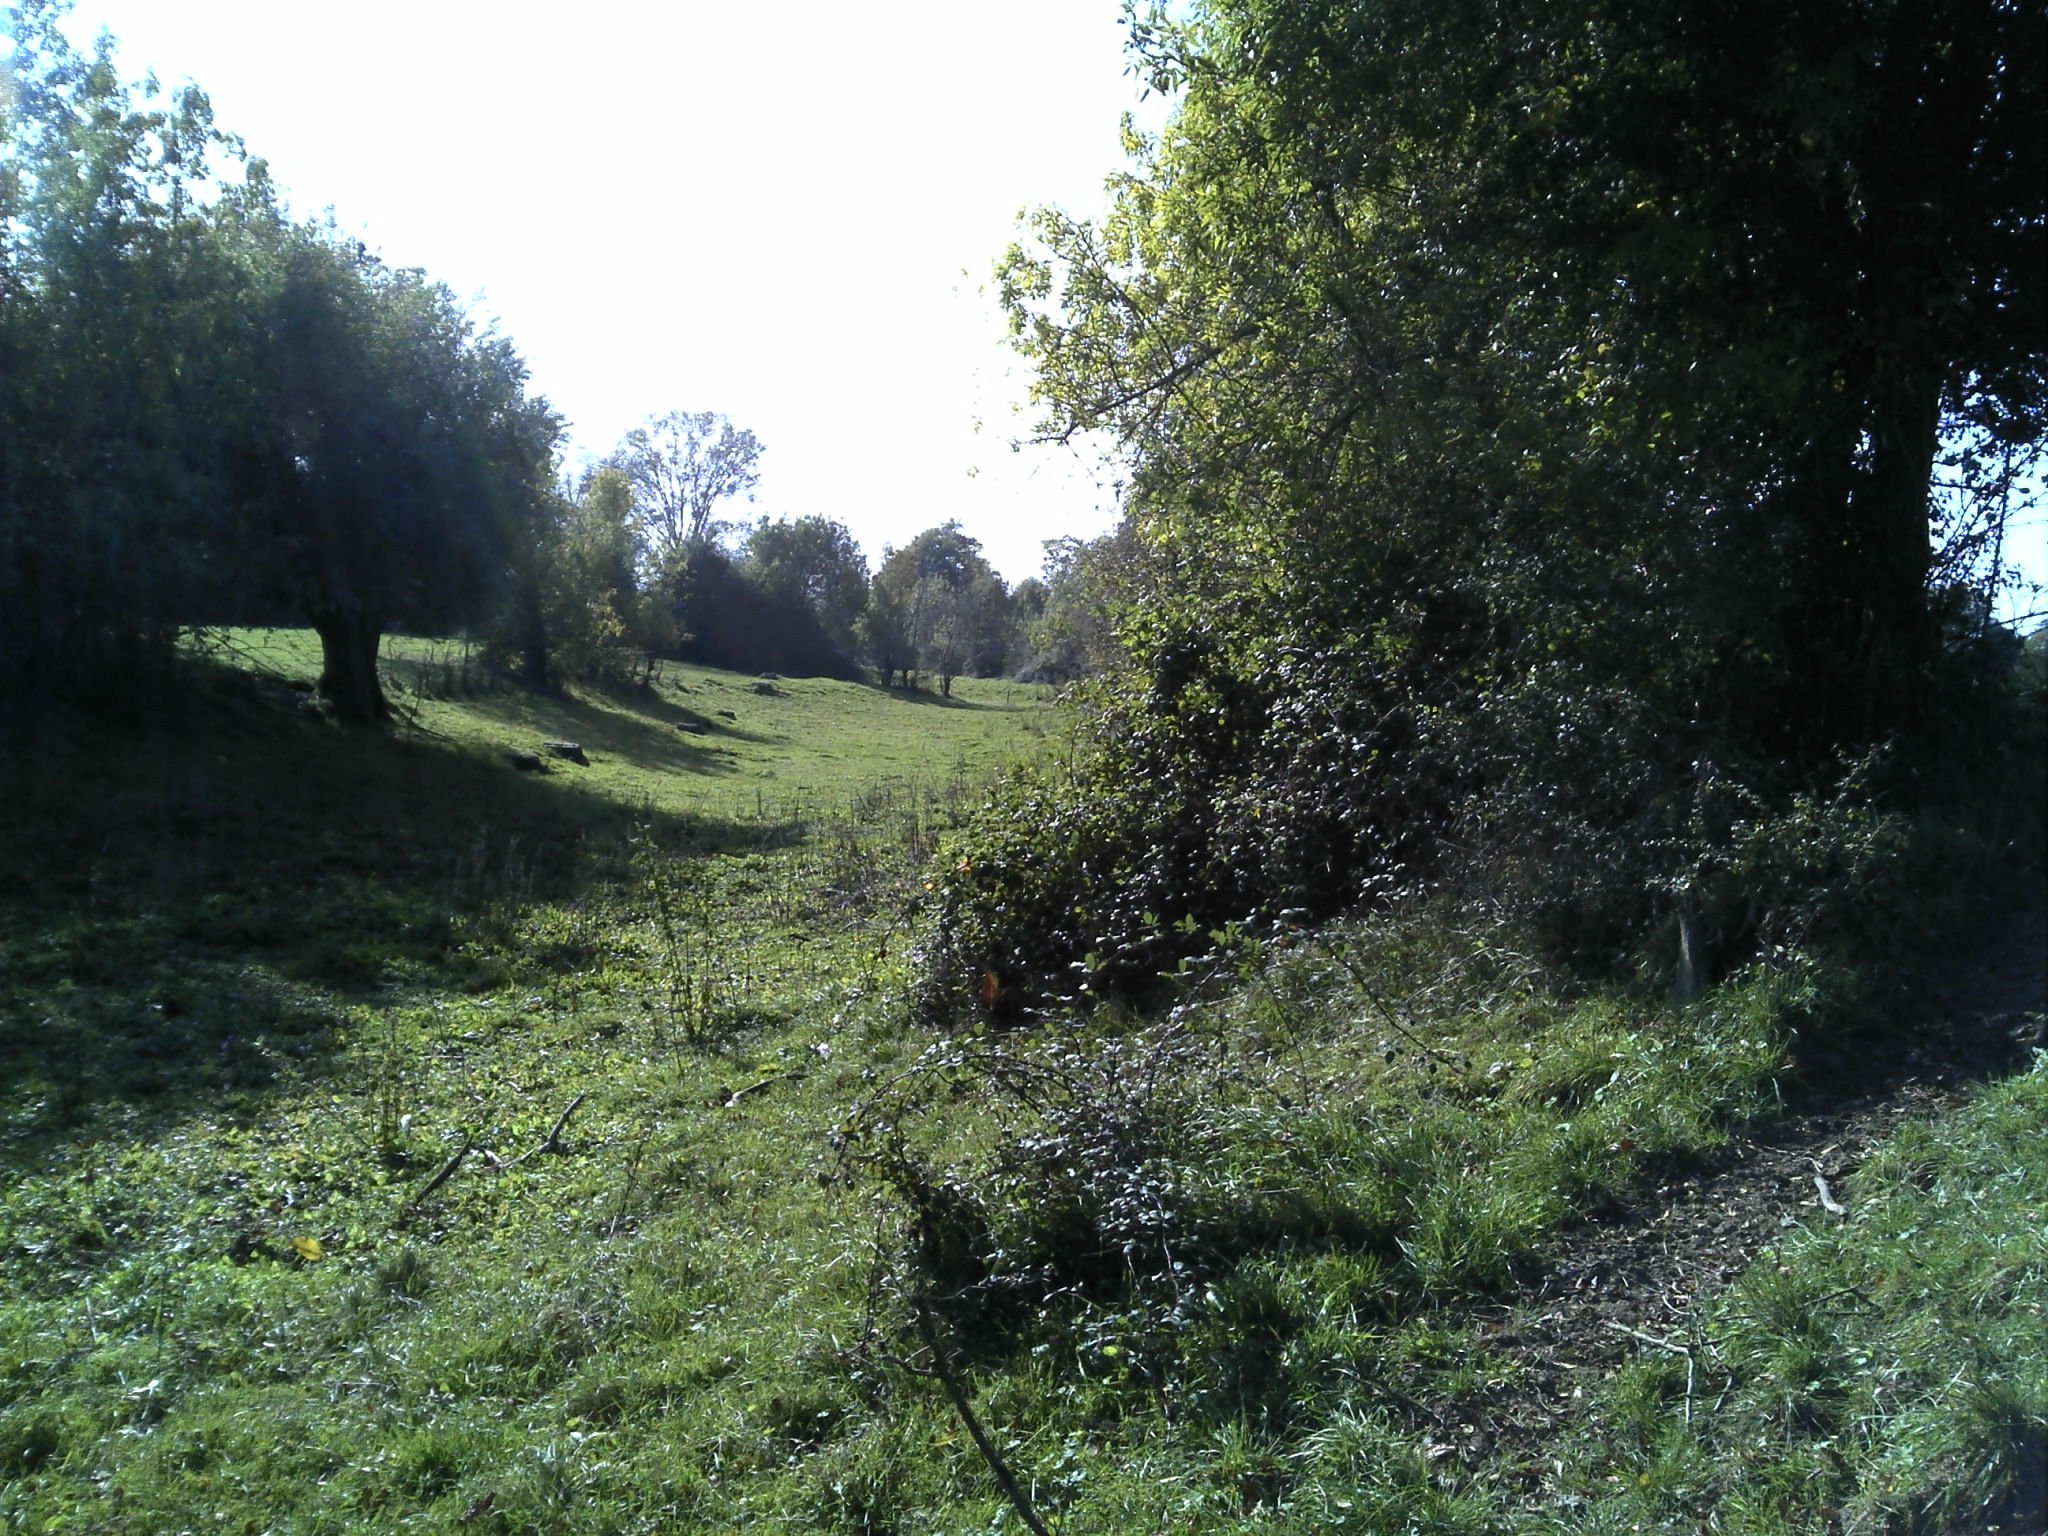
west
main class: Grassland
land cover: Grassland without tree/shrub cover
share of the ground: > 75 %
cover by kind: herbaceous plants 100 %
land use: Agriculture (excluding fallow land and kitchen gardens)
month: October
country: FR
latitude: 47.3315
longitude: -1.3008
